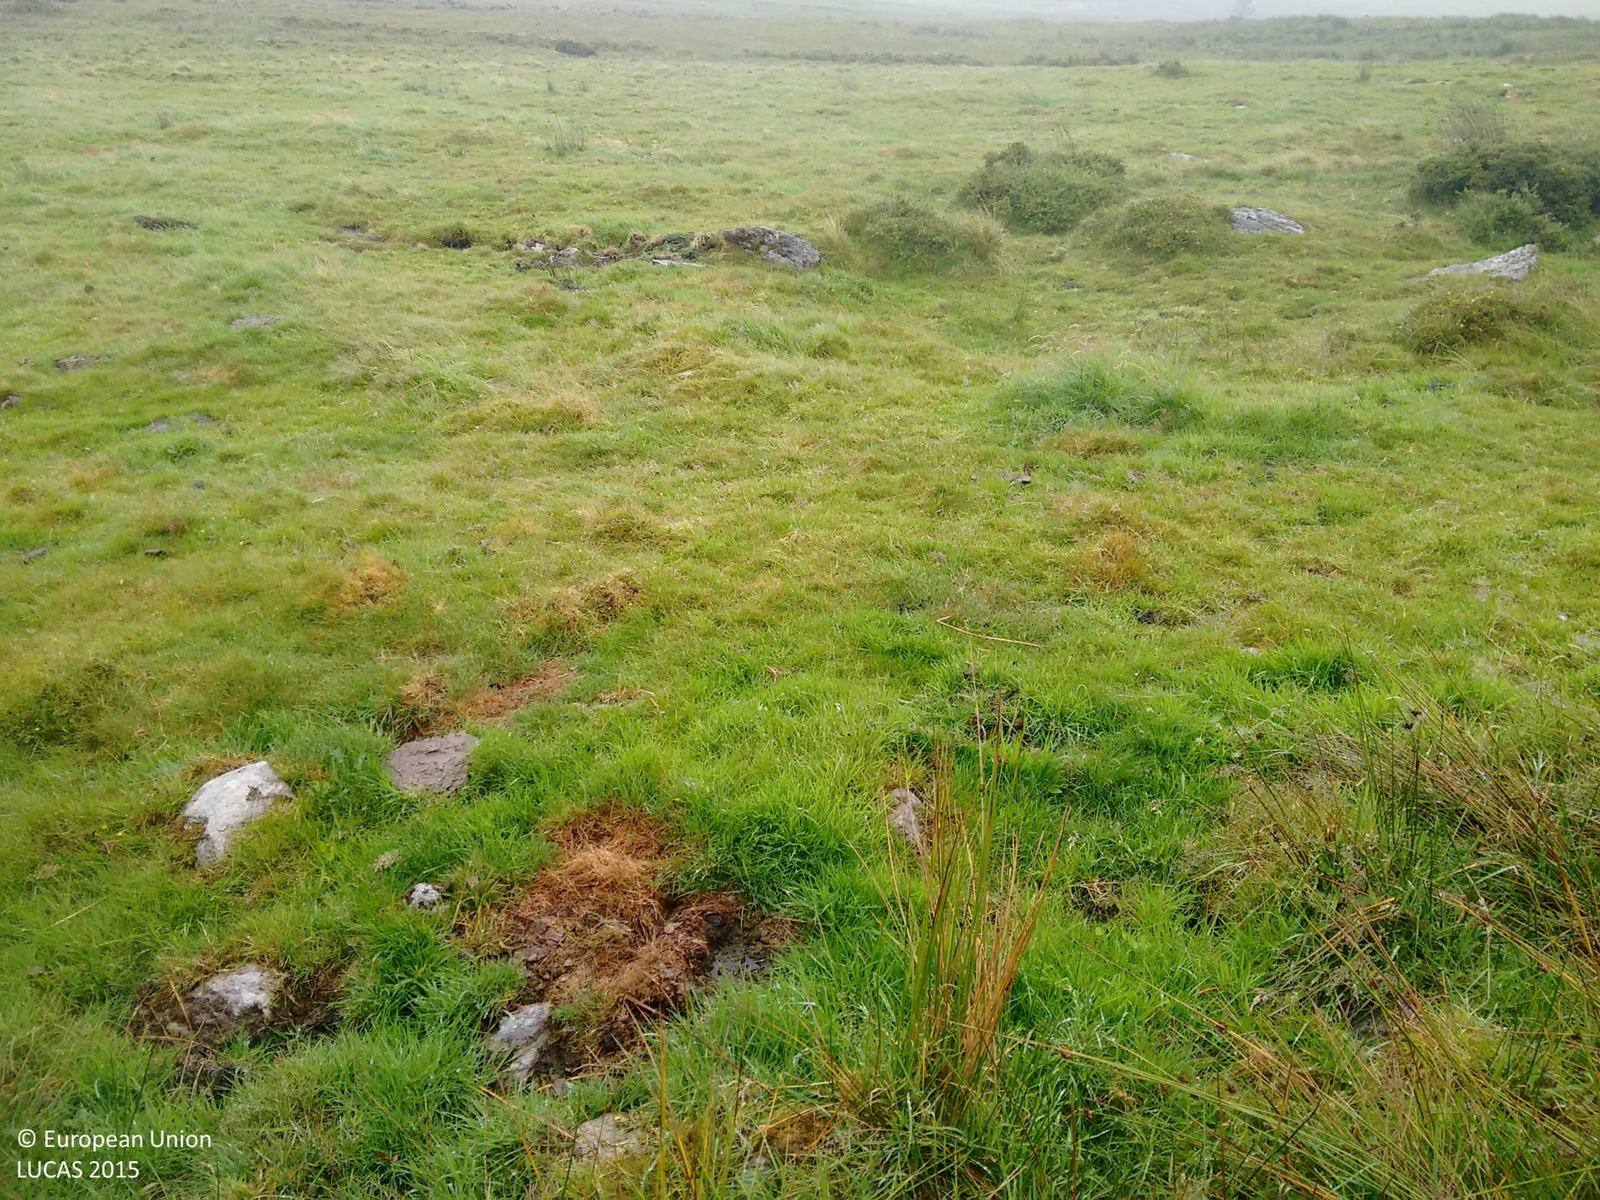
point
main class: Grassland
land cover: Grassland without tree/shrub cover
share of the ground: > 75 %
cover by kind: herbaceous plants 100 %
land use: Agriculture (excluding fallow land and kitchen gardens)
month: August
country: GB
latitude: 53.0284
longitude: -4.2495
